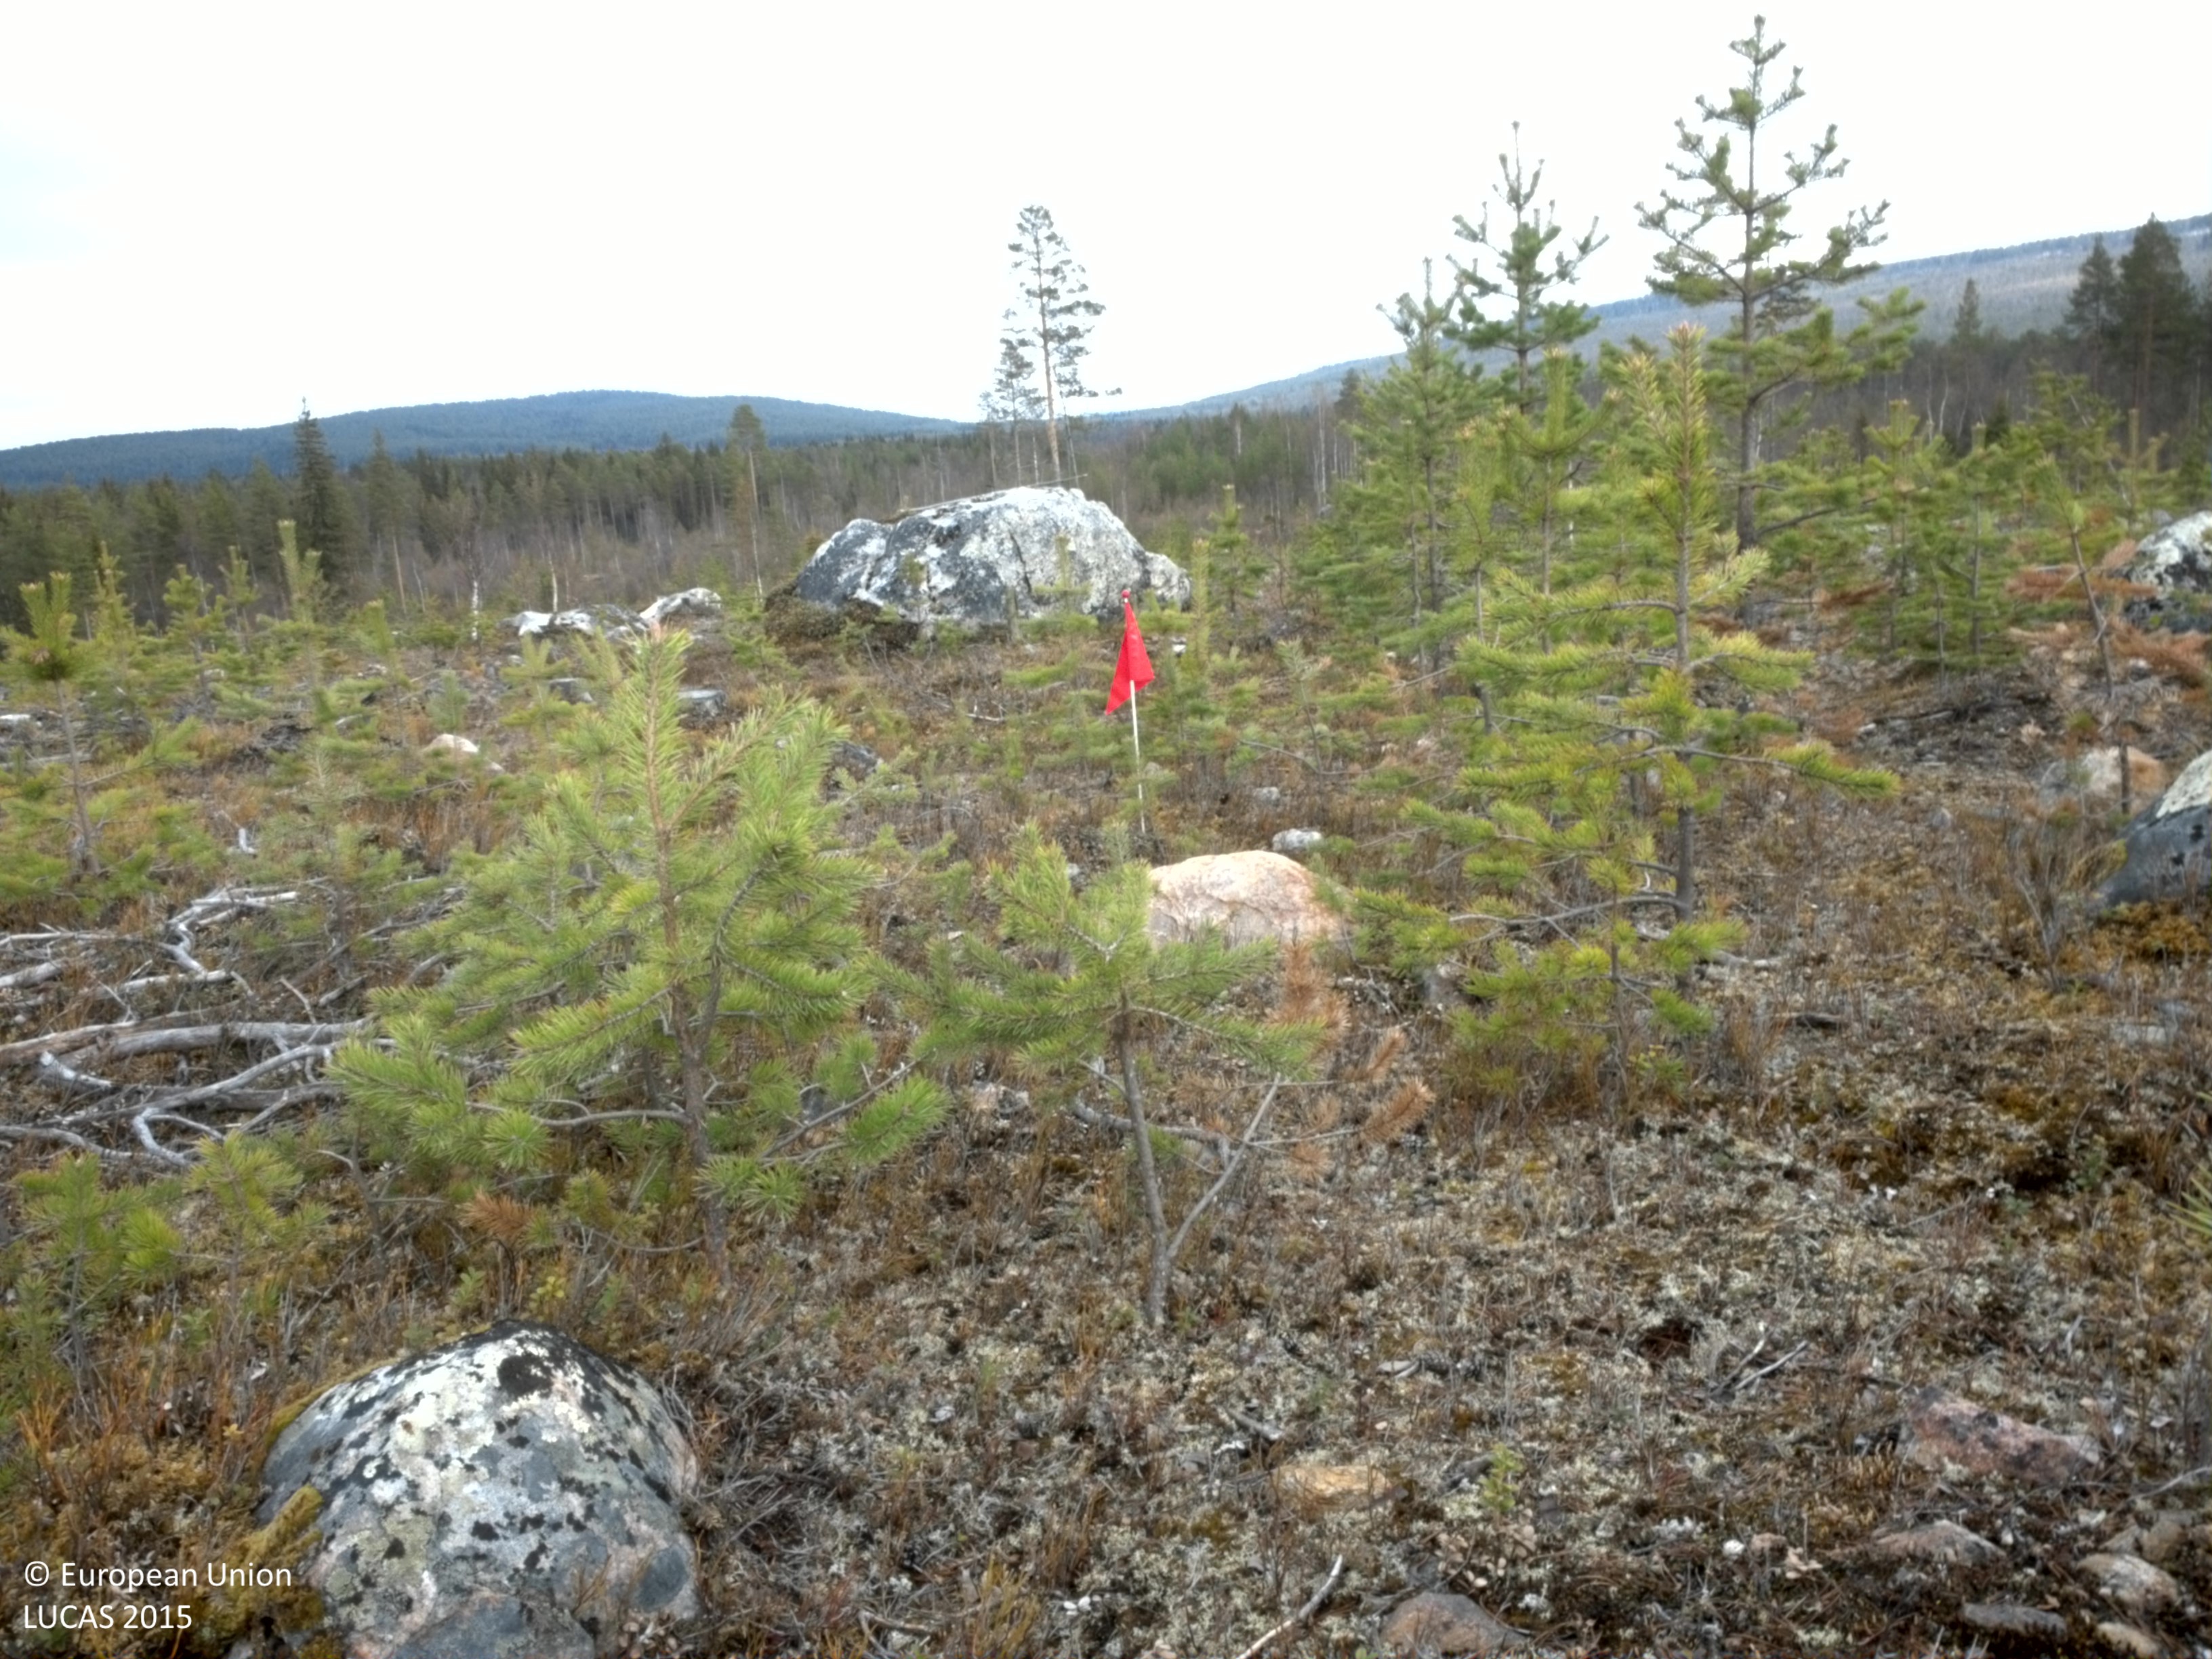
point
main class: Woodland
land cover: Pine dominated coniferous woodland
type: boreal forest
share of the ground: 25 - 50 %
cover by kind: coniferous forest trees 40 %, shrubs 40 %, lichens and mosses 15 %, unconsolidated bare surface 5 %
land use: Forestry
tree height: < 5 m
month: May
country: SE
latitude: 66.3712
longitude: 23.5583
